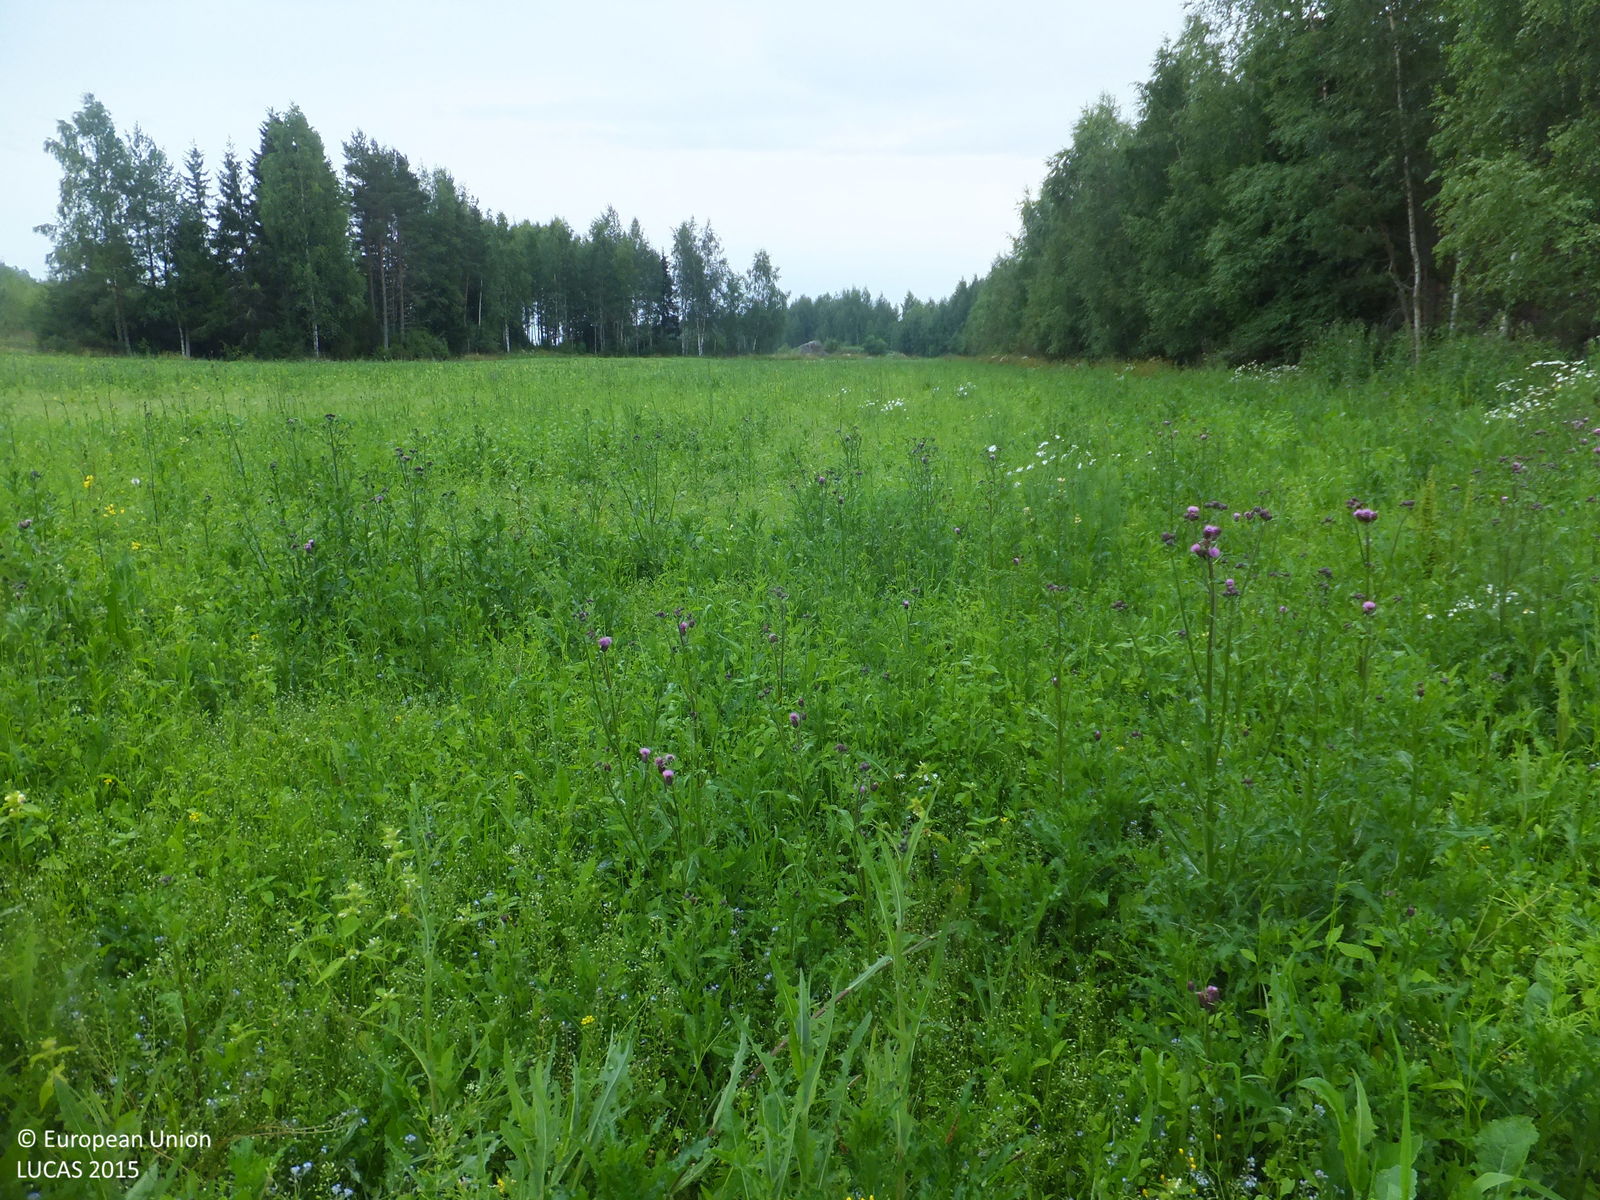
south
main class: Grassland
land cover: Grassland without tree/shrub cover
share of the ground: > 75 %
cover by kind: herbaceous plants 95 %, shrubs 5 %
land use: Agriculture (excluding fallow land and kitchen gardens)
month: July
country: FI
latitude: 63.0764
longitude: 22.0611
